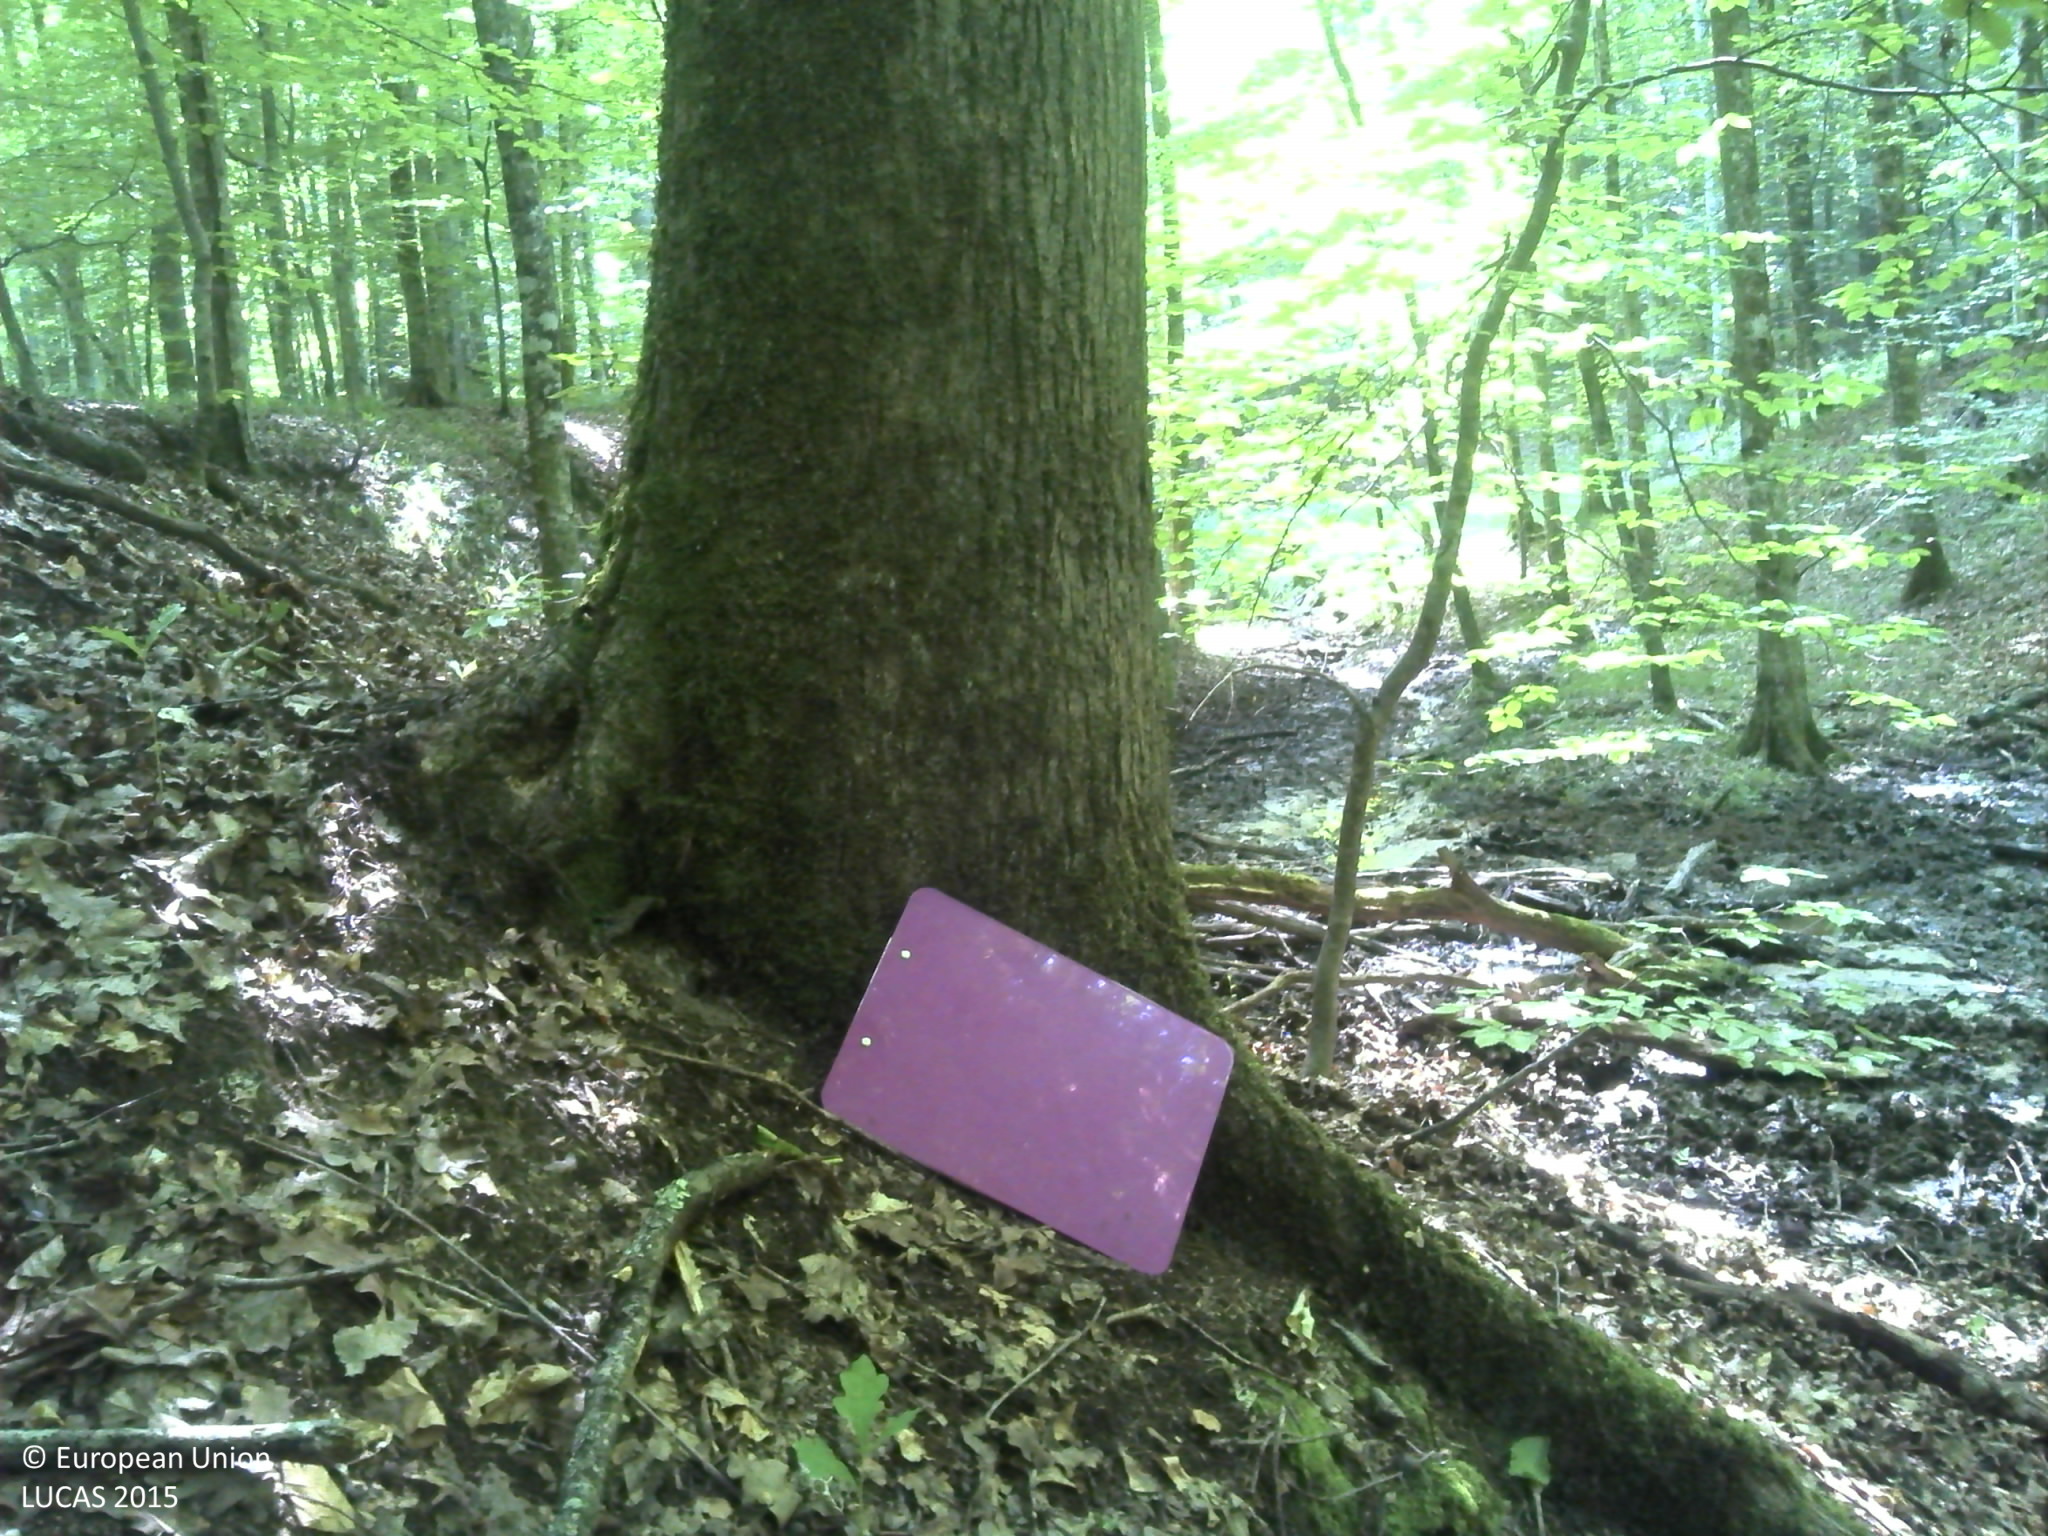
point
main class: Woodland
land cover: Broadleaved woodland
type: acidophilous oak and oak-birch forest
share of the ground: > 75 %
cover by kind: broadleaved forest trees 90 %, shrubs 5 %, herbaceous plants 5 %
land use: Forestry
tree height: > 5 m
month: June
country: HR
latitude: 45.6363
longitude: 17.7387
